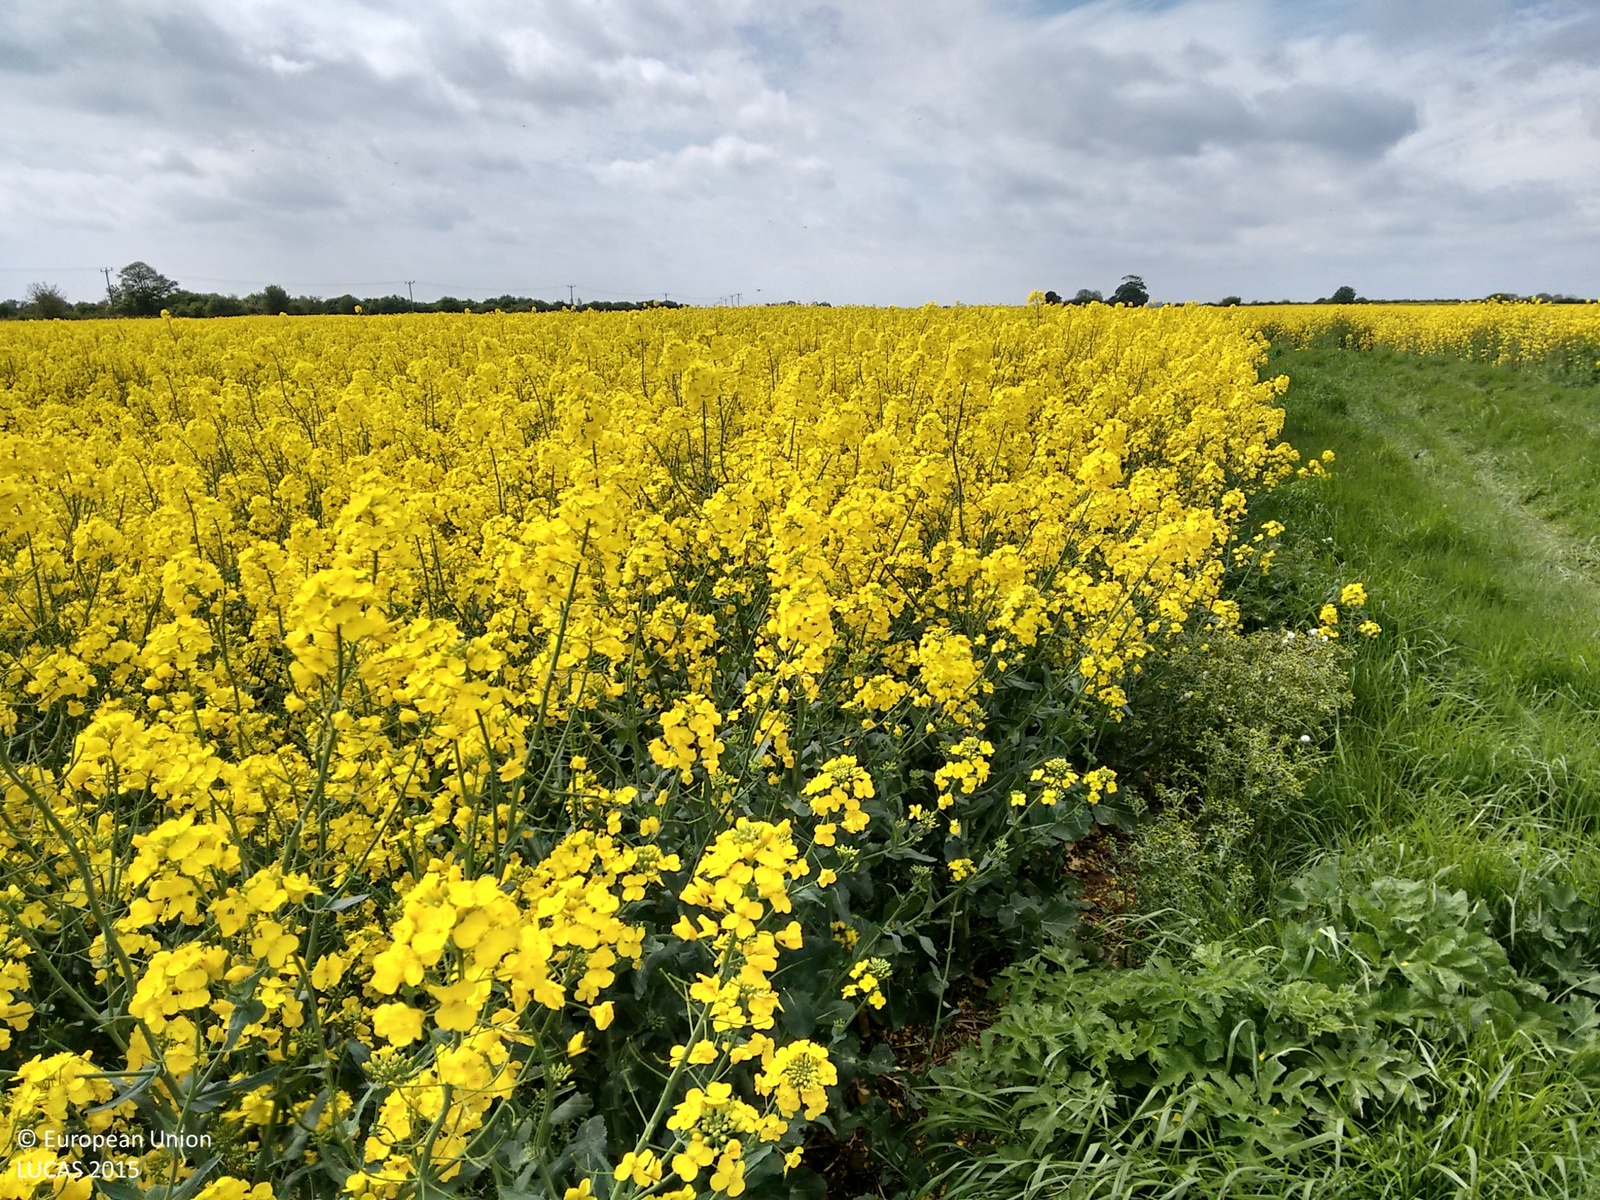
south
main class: Cropland
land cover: Rape and turnip rape
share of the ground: > 75 %
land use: Agriculture (excluding fallow land and kitchen gardens)
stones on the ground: < 10 %
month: May
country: GB
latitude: 53.2120
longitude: 0.3129
